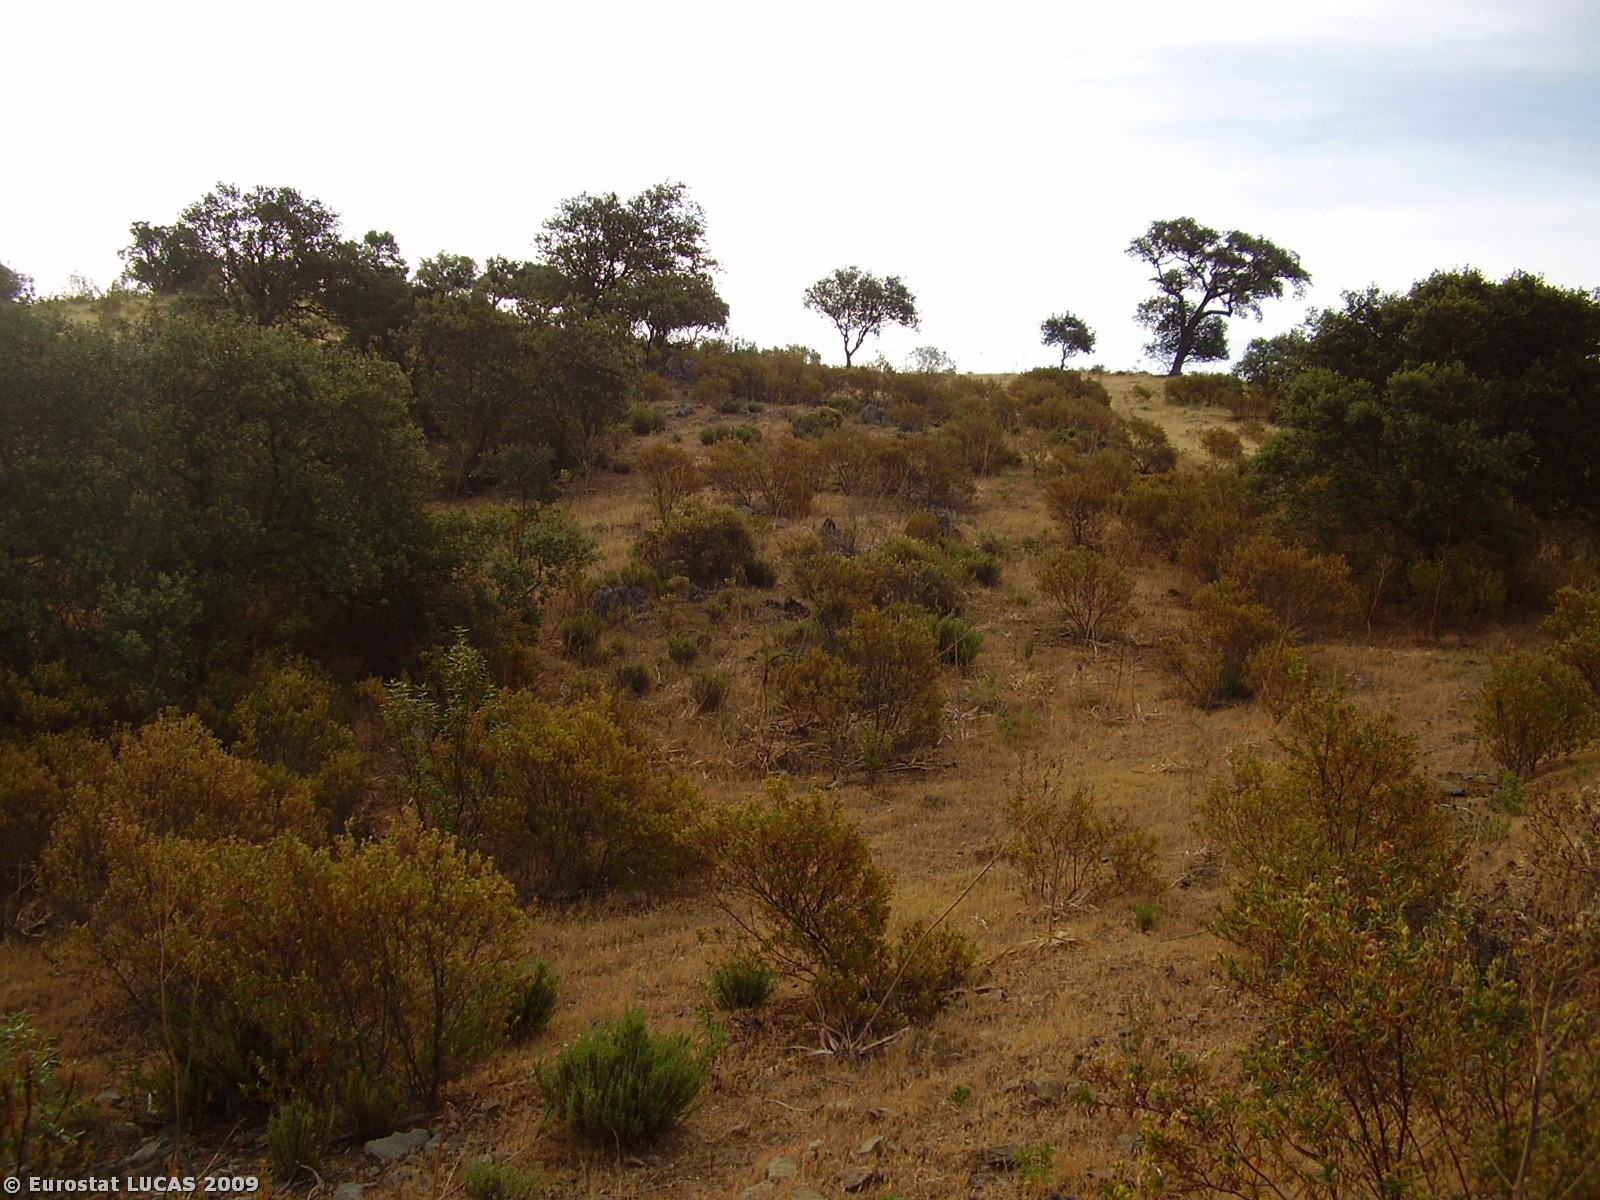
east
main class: Woodland
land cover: Broadleaved woodland
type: broadleaved evergreen forest
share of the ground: 50 - 75 %
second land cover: Spontaneously vegetated surfaces
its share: 50 - 75 %
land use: Forestry
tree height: > 5 m
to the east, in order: Broadleaved woodland; Spontaneously vegetated surfaces; Broadleaved woodland; Tracks; Fences; Broadleaved woodland; Rivers and streams; Broadleaved woodland
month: May
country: PT
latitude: 37.5942
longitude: -7.5791
